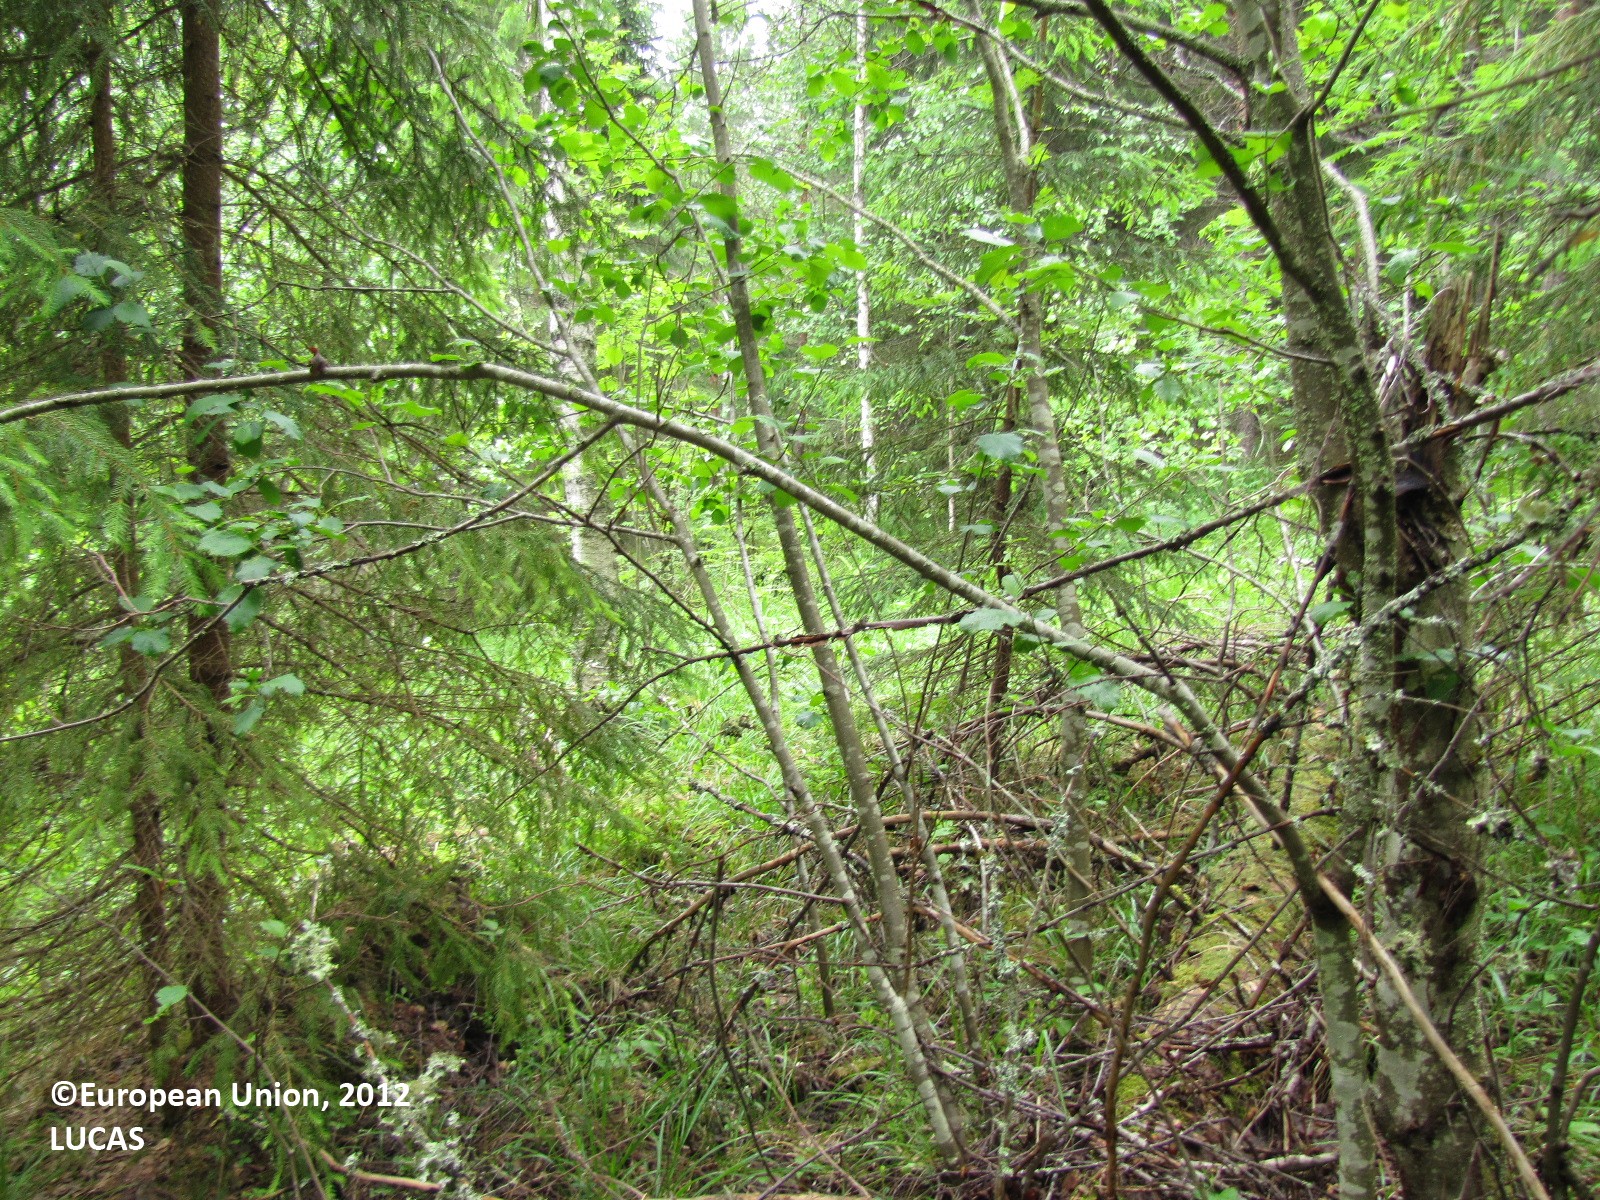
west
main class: Woodland
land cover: Spruce dominated coniferous woodland
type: boreal forest
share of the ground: 50 - 75 %
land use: Forestry
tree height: > 5 m
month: June
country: FI
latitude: 61.5516
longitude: 24.7244
